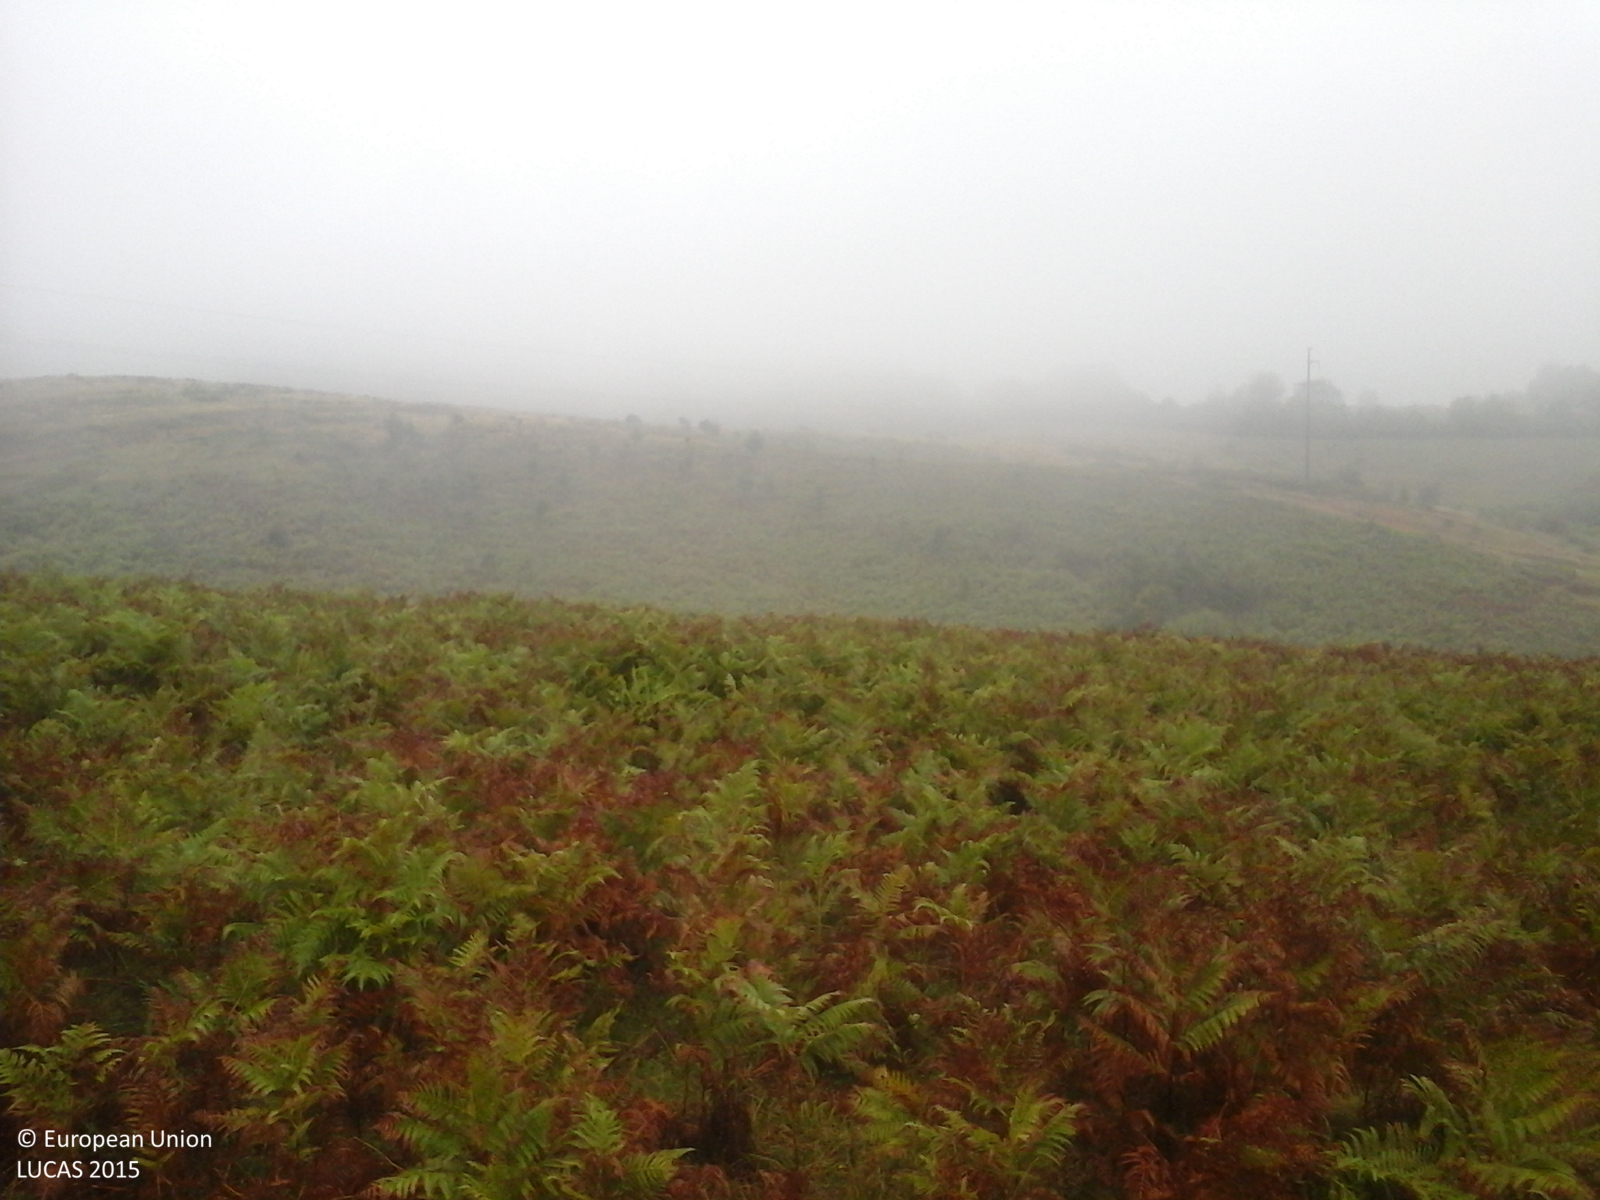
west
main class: Grassland
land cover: Spontaneously vegetated surfaces
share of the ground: > 75 %
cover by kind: herbaceous plants 100 %
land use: Agriculture (excluding fallow land and kitchen gardens)
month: September
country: RO
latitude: 46.9833
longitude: 22.4778
